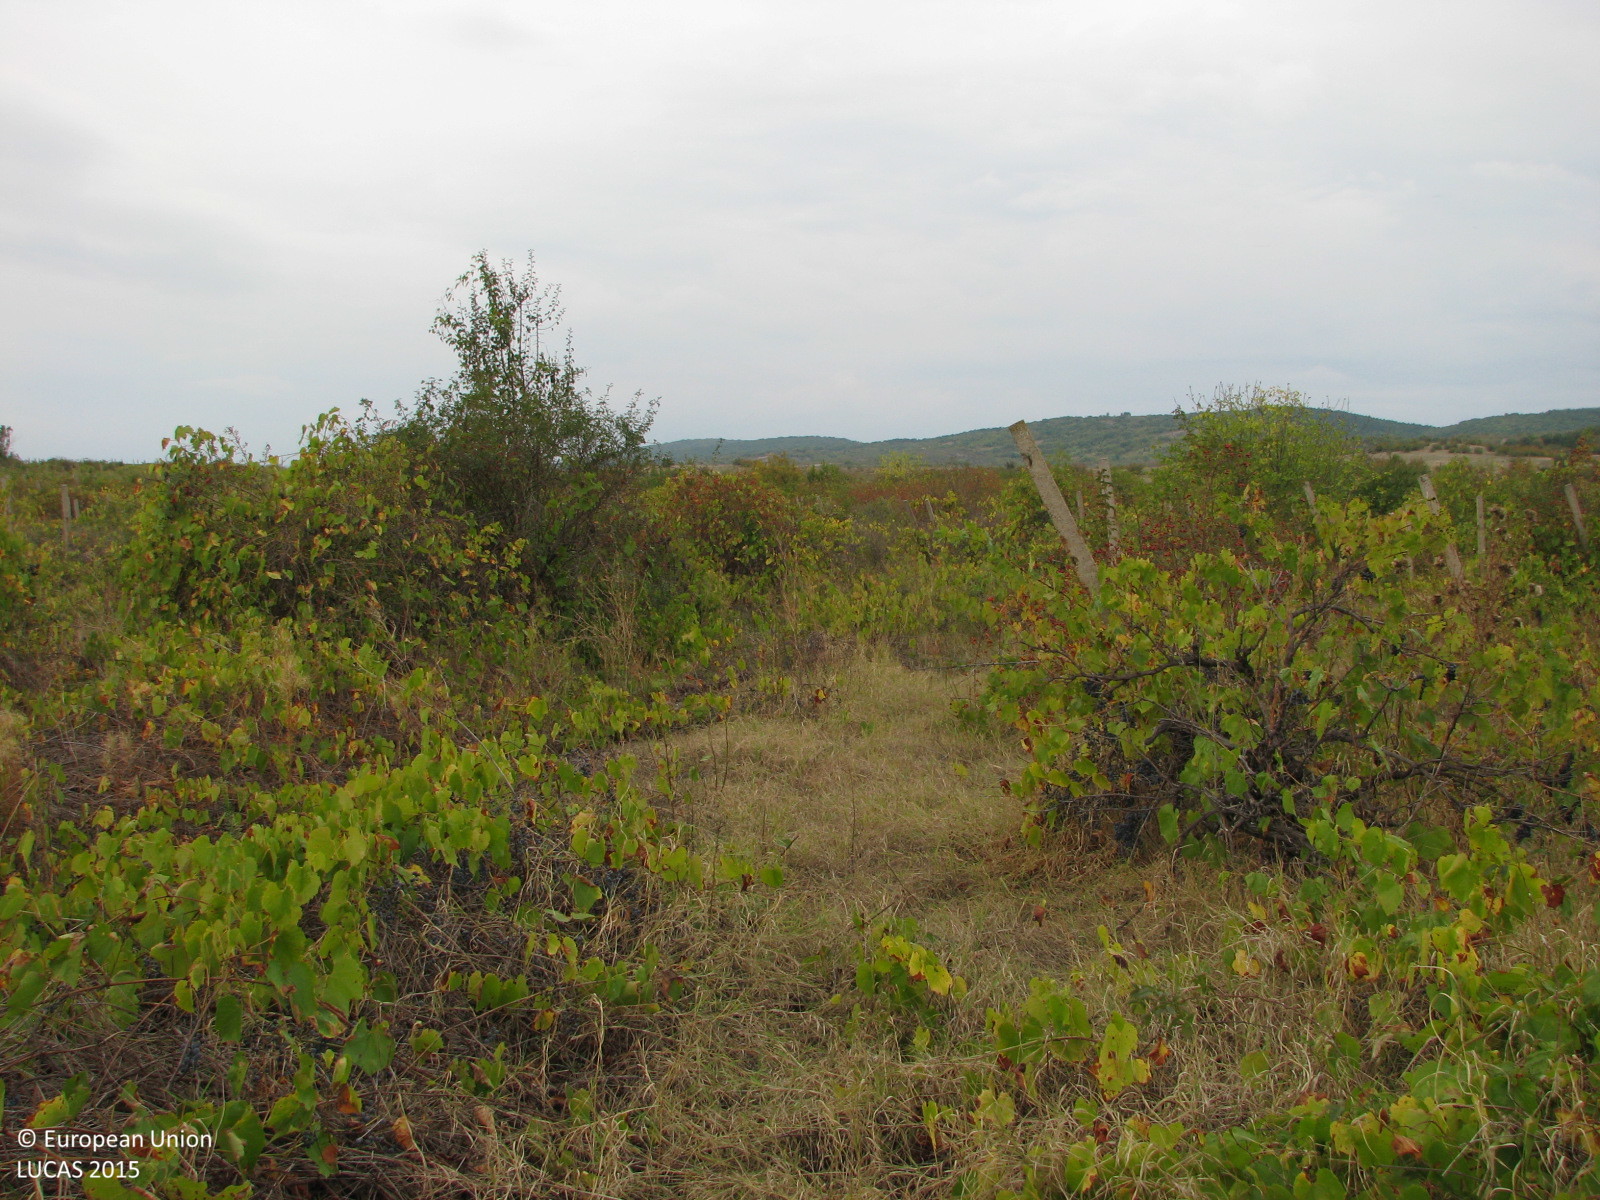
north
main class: Cropland
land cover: Vineyards
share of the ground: > 75 %
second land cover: Spontaneously vegetated surfaces
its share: 50 - 75 %
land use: Agriculture (excluding fallow land and kitchen gardens)
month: October
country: BG
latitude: 42.5685
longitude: 26.1031
